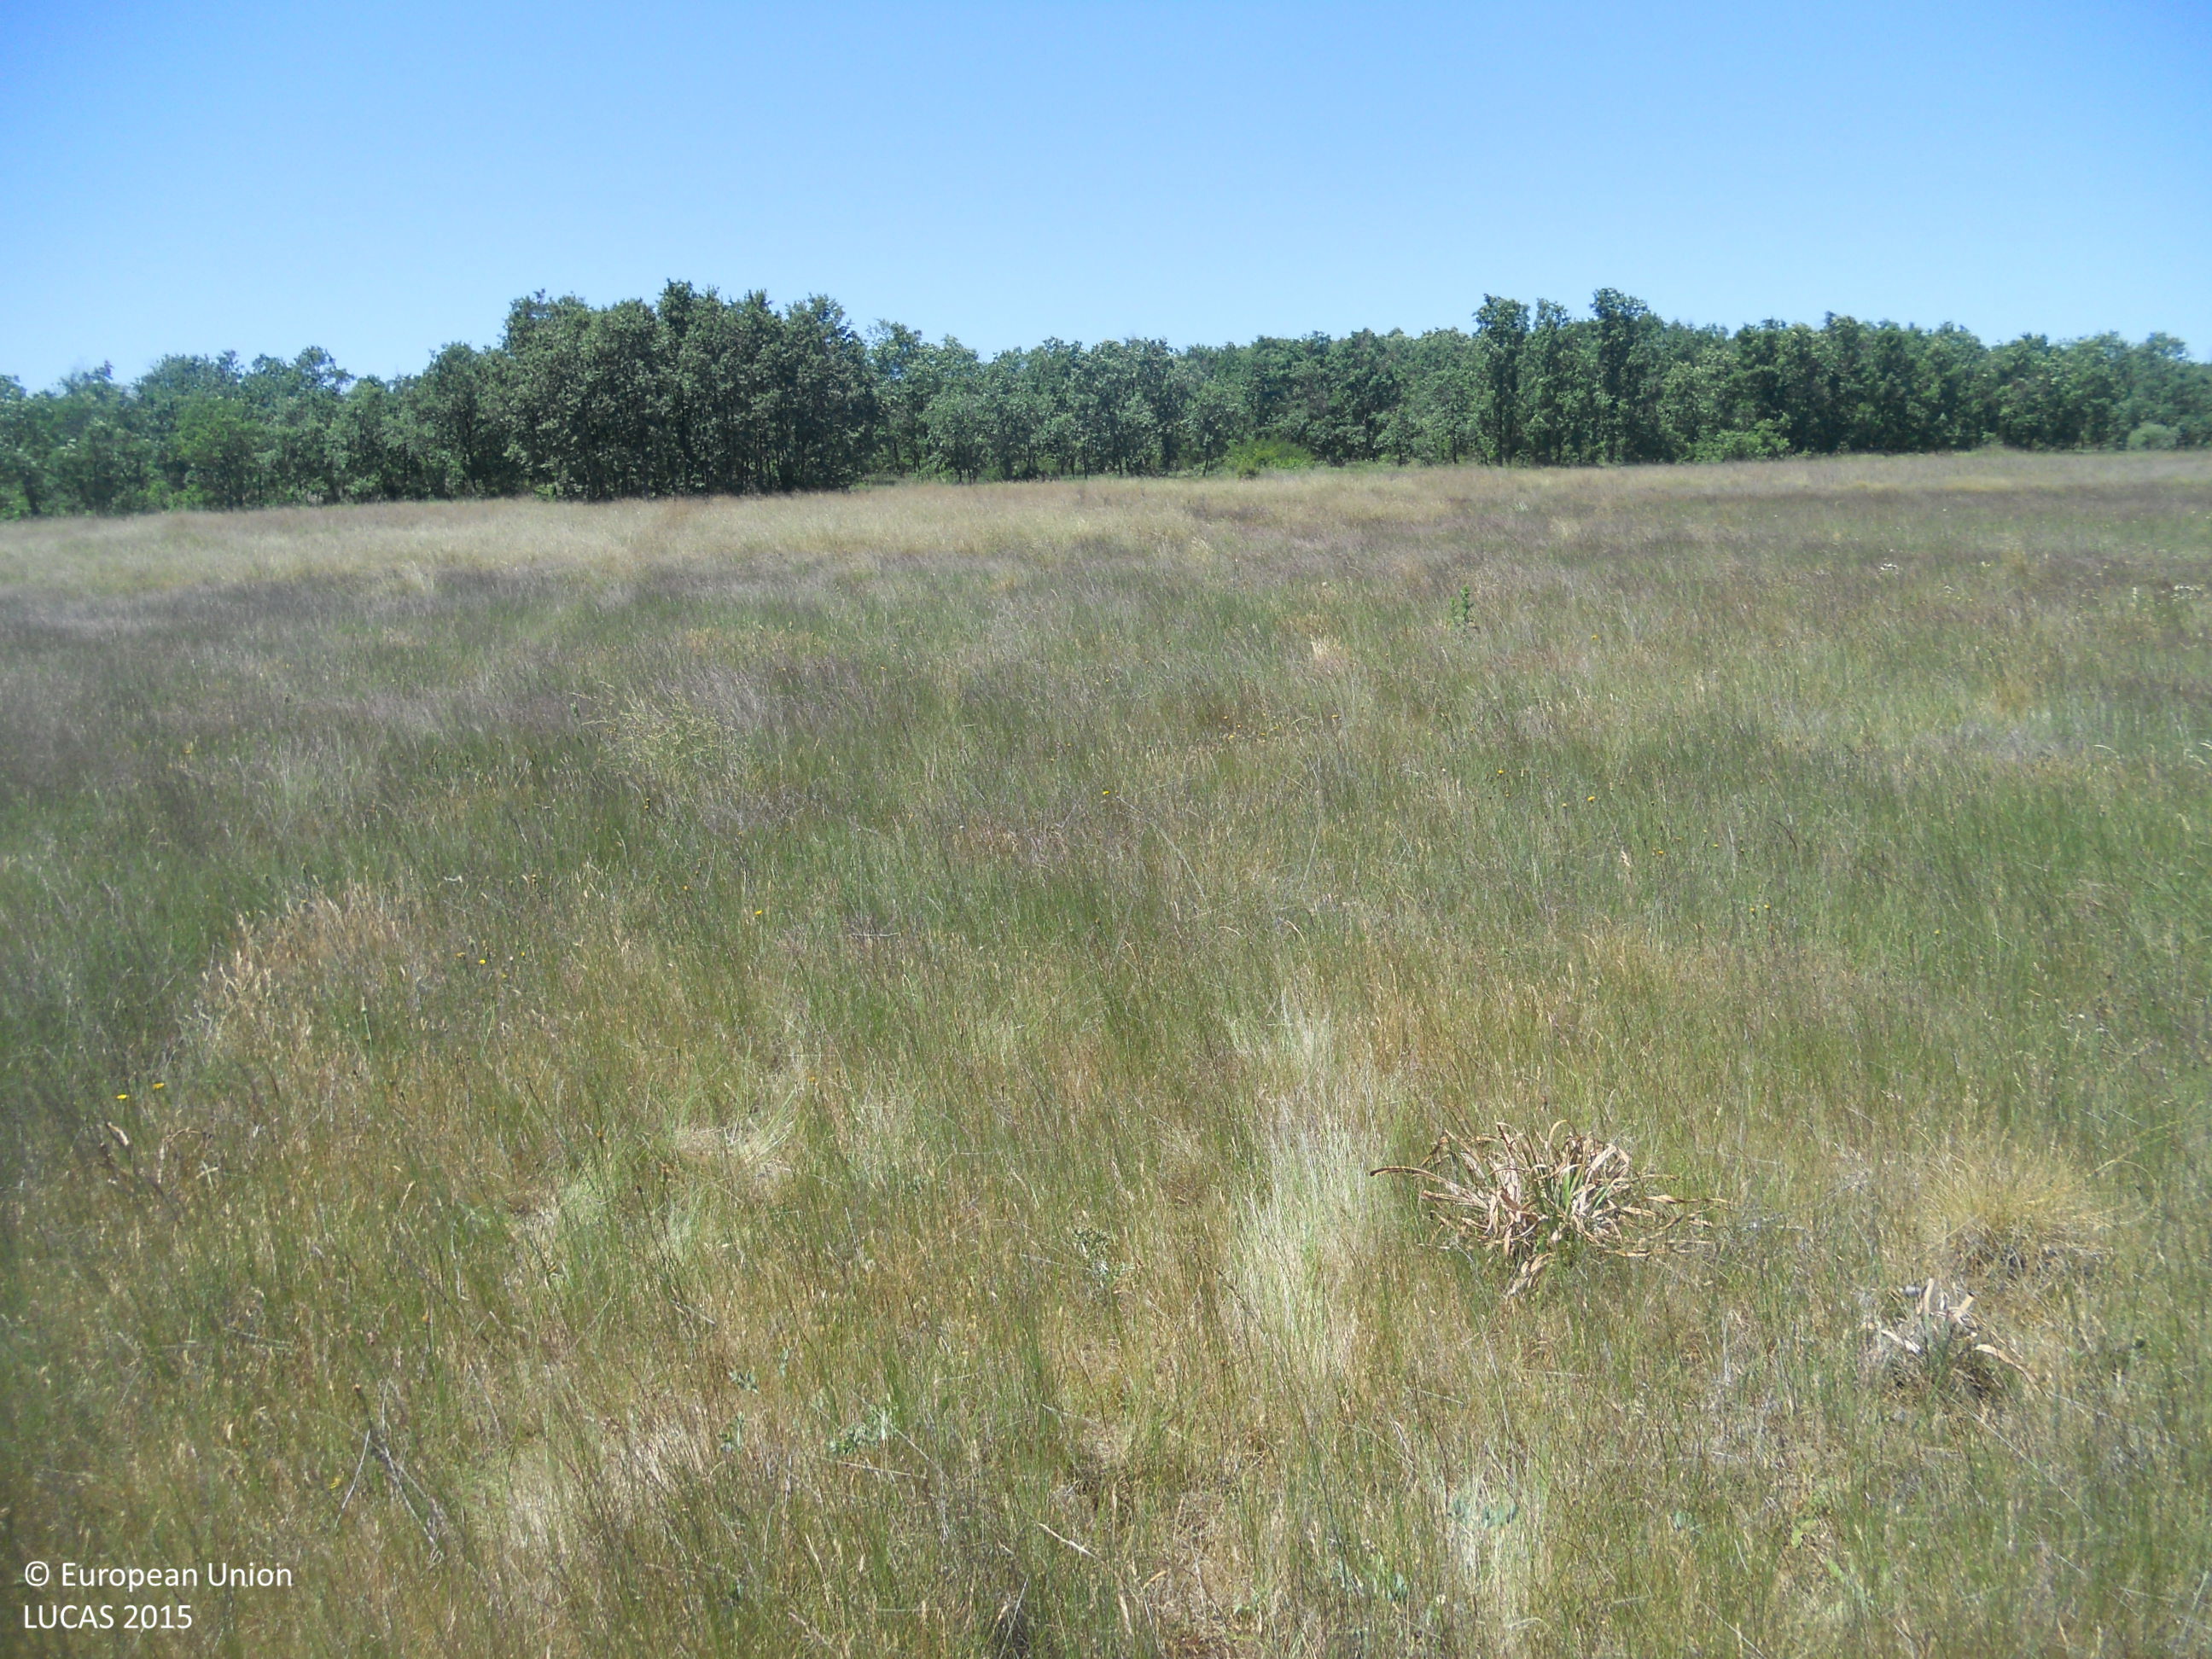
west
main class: Grassland
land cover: Grassland without tree/shrub cover
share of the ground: > 75 %
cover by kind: herbaceous plants 95 %, shrubs 5 %
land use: Forestry
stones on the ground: > 50 %
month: June
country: ES
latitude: 42.4888
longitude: -4.8392
